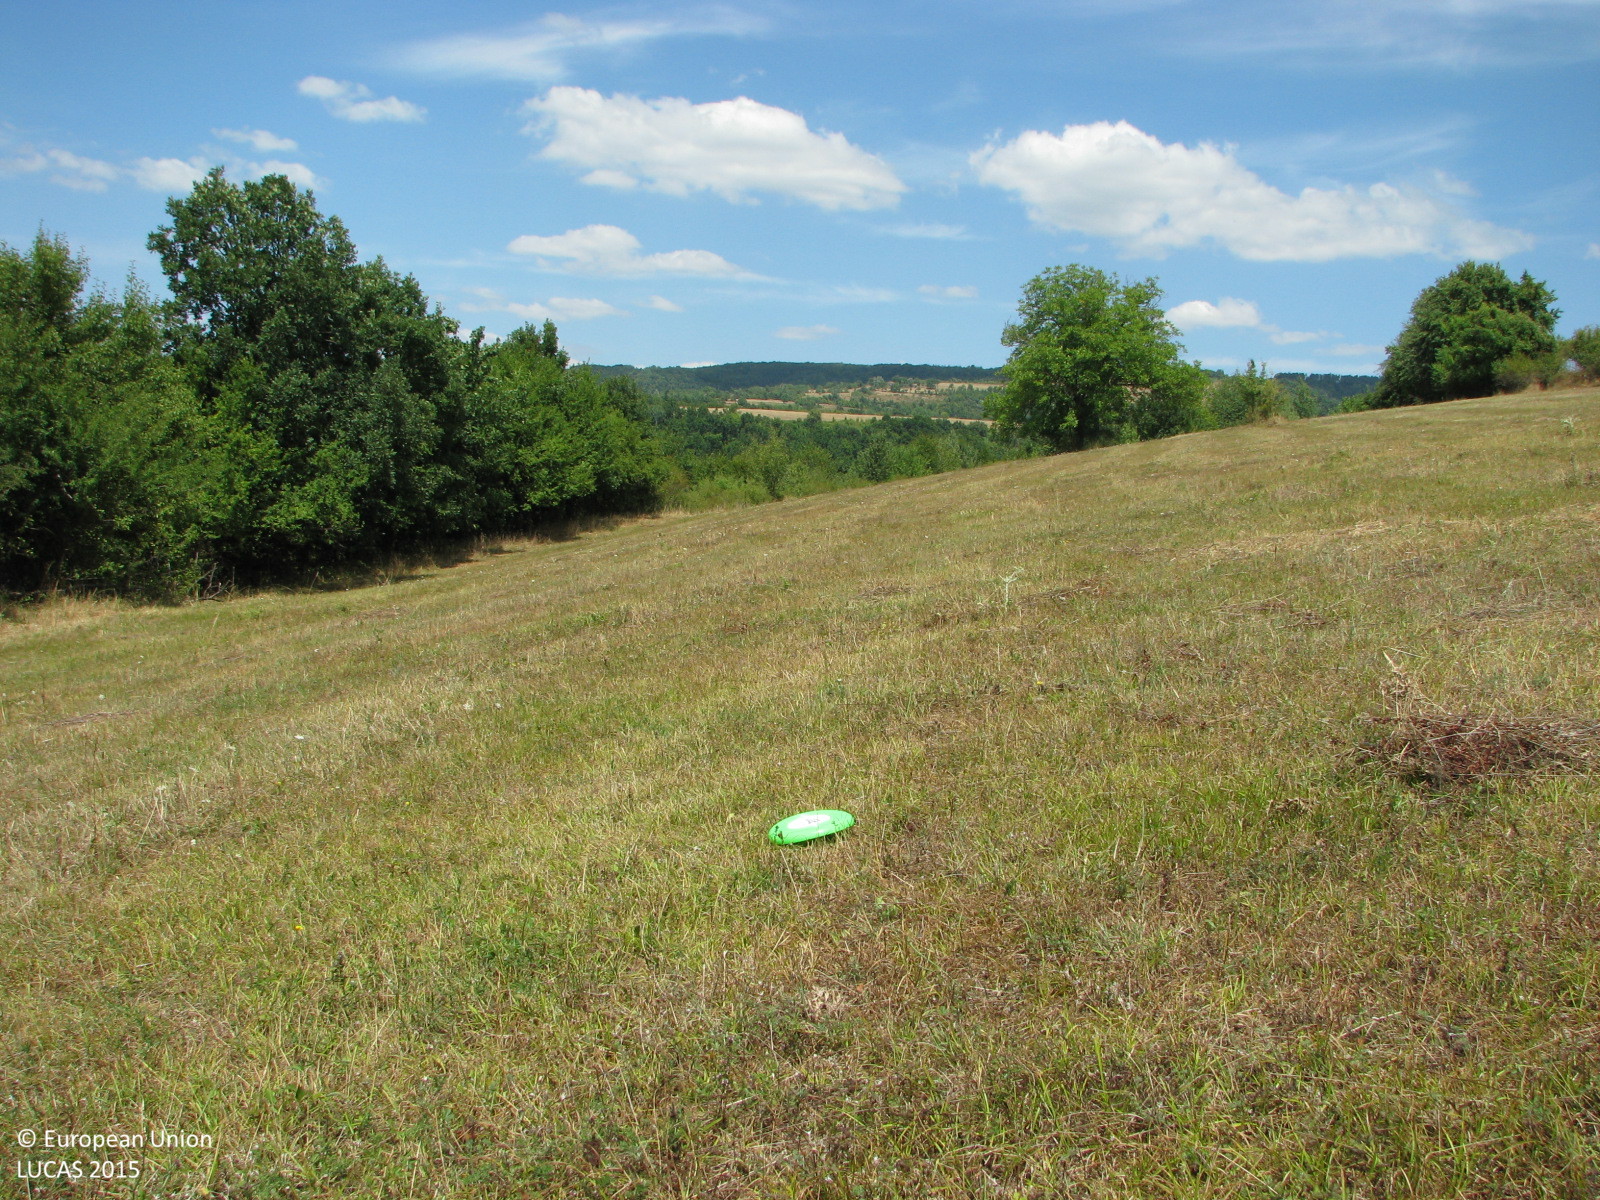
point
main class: Grassland
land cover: Grassland without tree/shrub cover
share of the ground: > 75 %
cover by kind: herbaceous plants 100 %
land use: Agriculture (excluding fallow land and kitchen gardens)
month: August
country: BG
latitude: 42.9691
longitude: 26.2392
